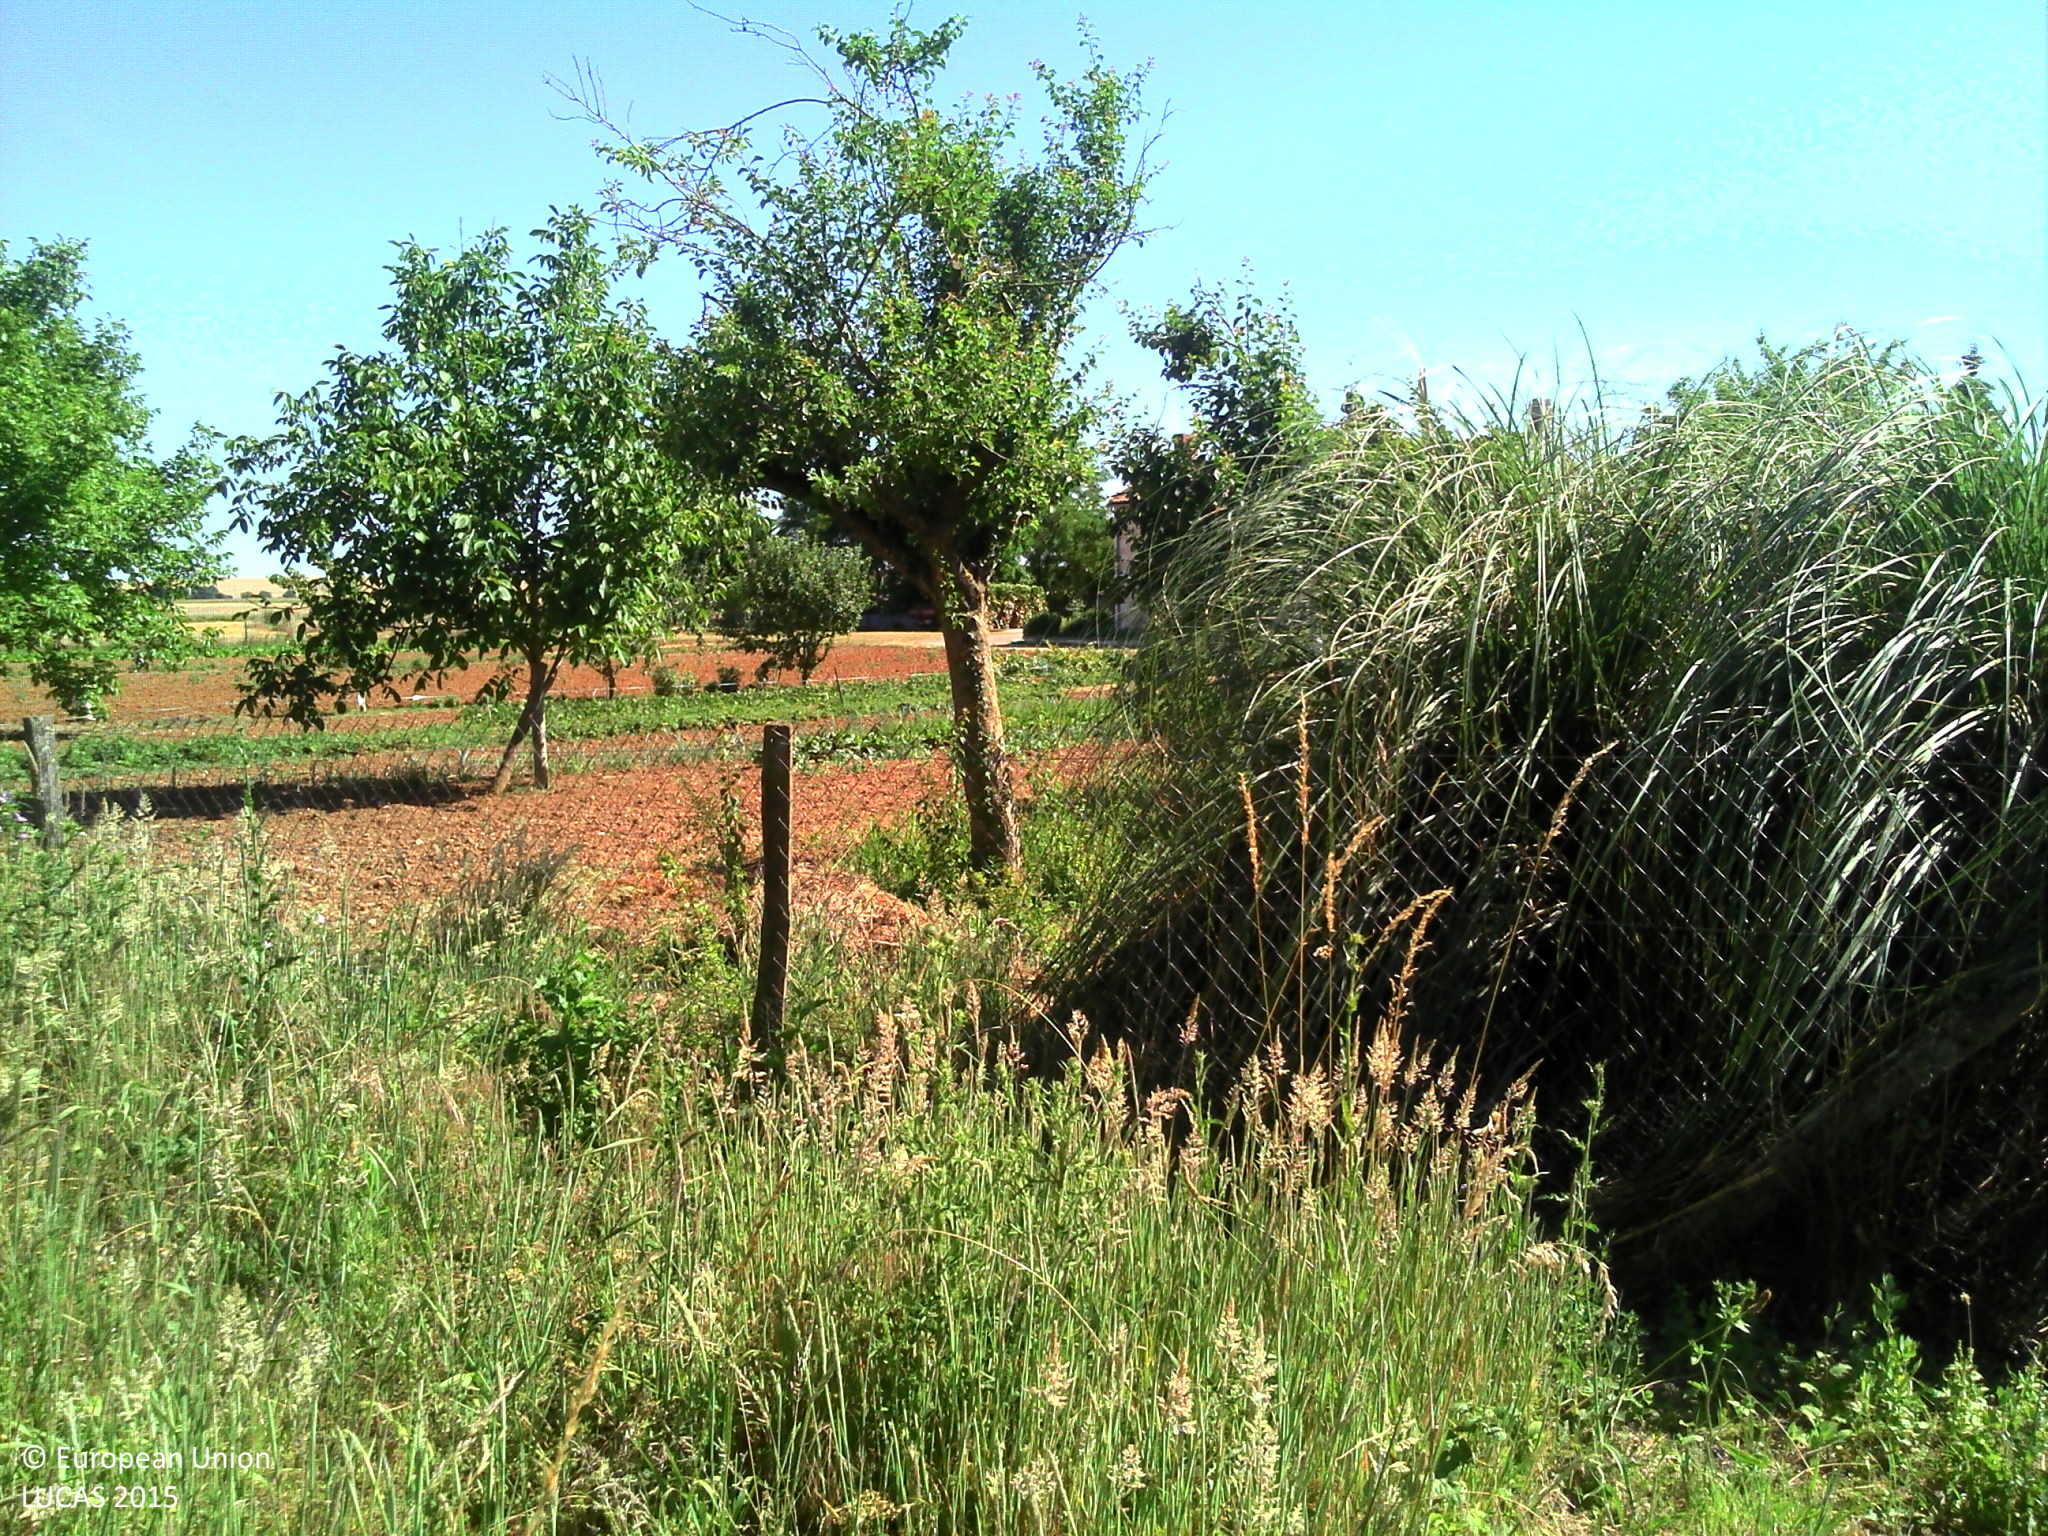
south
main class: Grassland
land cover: Spontaneously vegetated surfaces
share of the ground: > 75 %
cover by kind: herbaceous plants 100 %
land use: Semi-natural and natural areas not in use
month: June
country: FR
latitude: 46.8726
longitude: 0.1246
